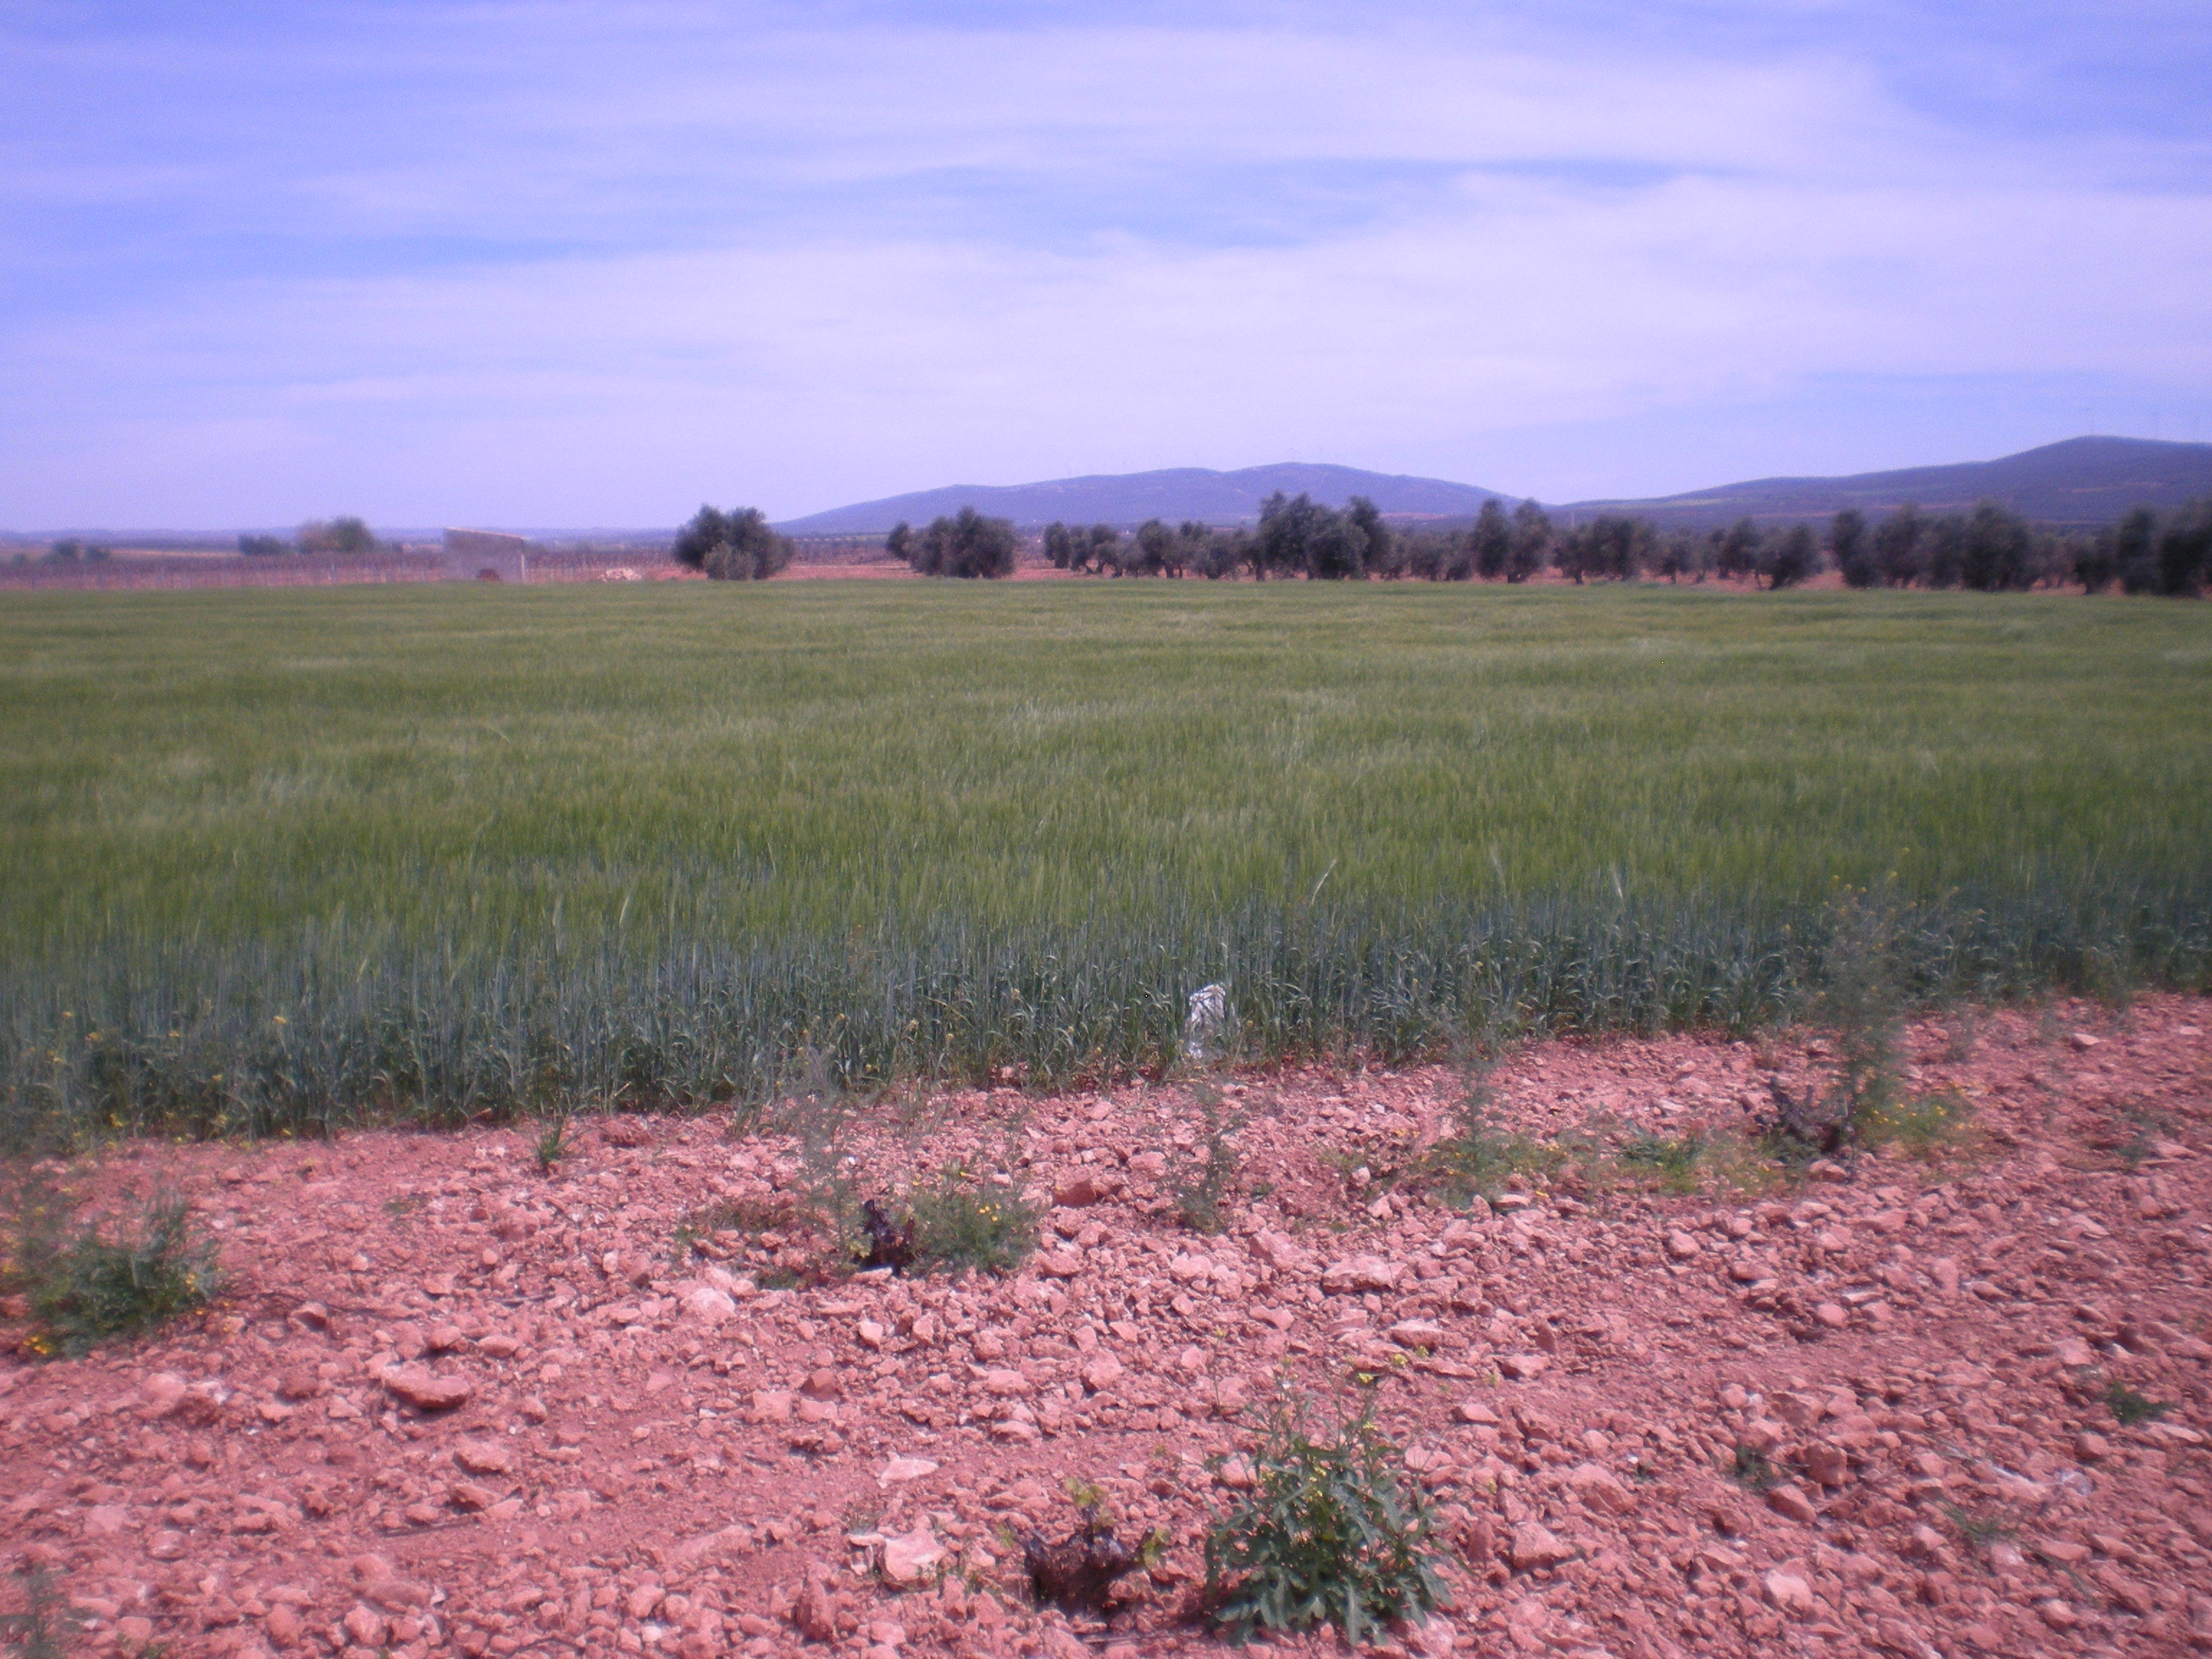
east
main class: Cropland
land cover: Vineyards
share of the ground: < 10 %
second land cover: Other bare soil
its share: > 75 %
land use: Agriculture (excluding fallow land and kitchen gardens)
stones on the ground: < 10 %
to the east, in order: Vineyards; Other bare soil; Barley; Grass margins; Olive groves; Grass margins; Tracks; Grass margins; Vineyards
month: April
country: ES
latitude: 38.8692
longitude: -3.2539
